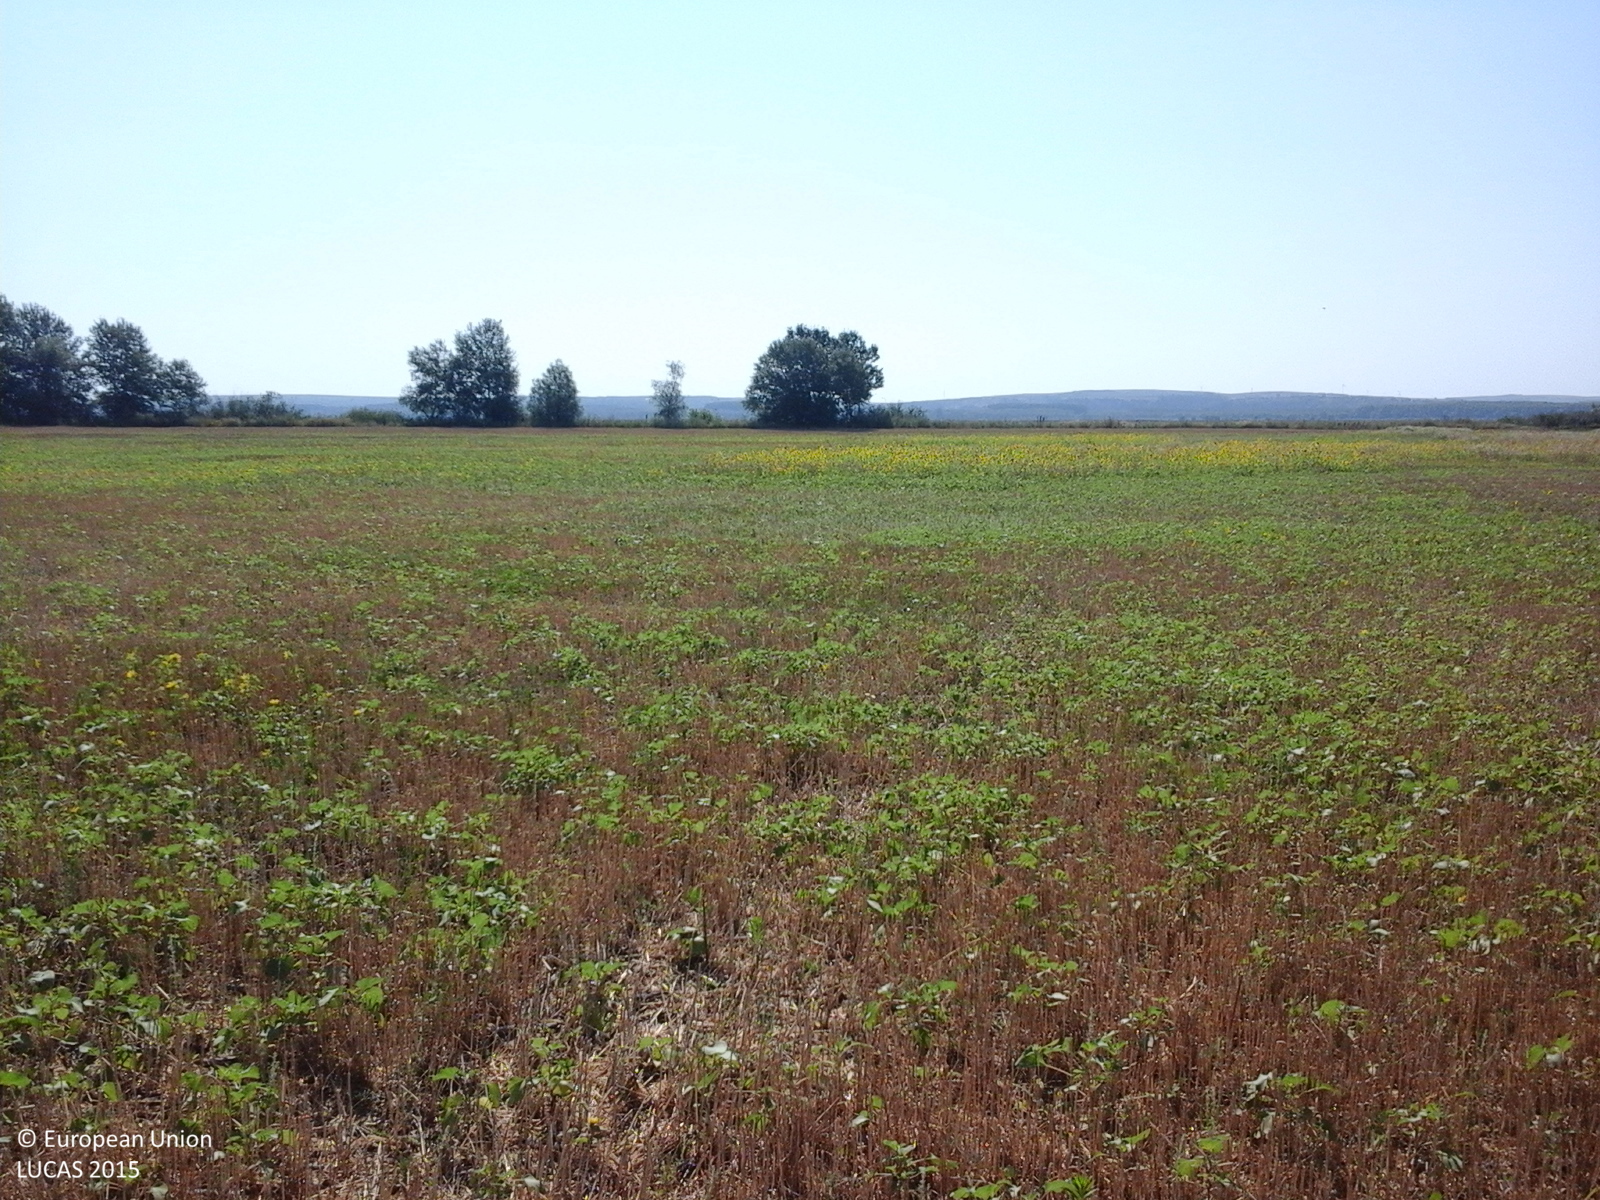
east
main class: Cropland
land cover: Common wheat
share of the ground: > 75 %
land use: Agriculture (excluding fallow land and kitchen gardens)
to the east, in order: Common wheat; Abandoned hedges; Rivers and streams; Spontaneously vegetated surfaces
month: July
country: RO
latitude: 44.2713
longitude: 27.9046
